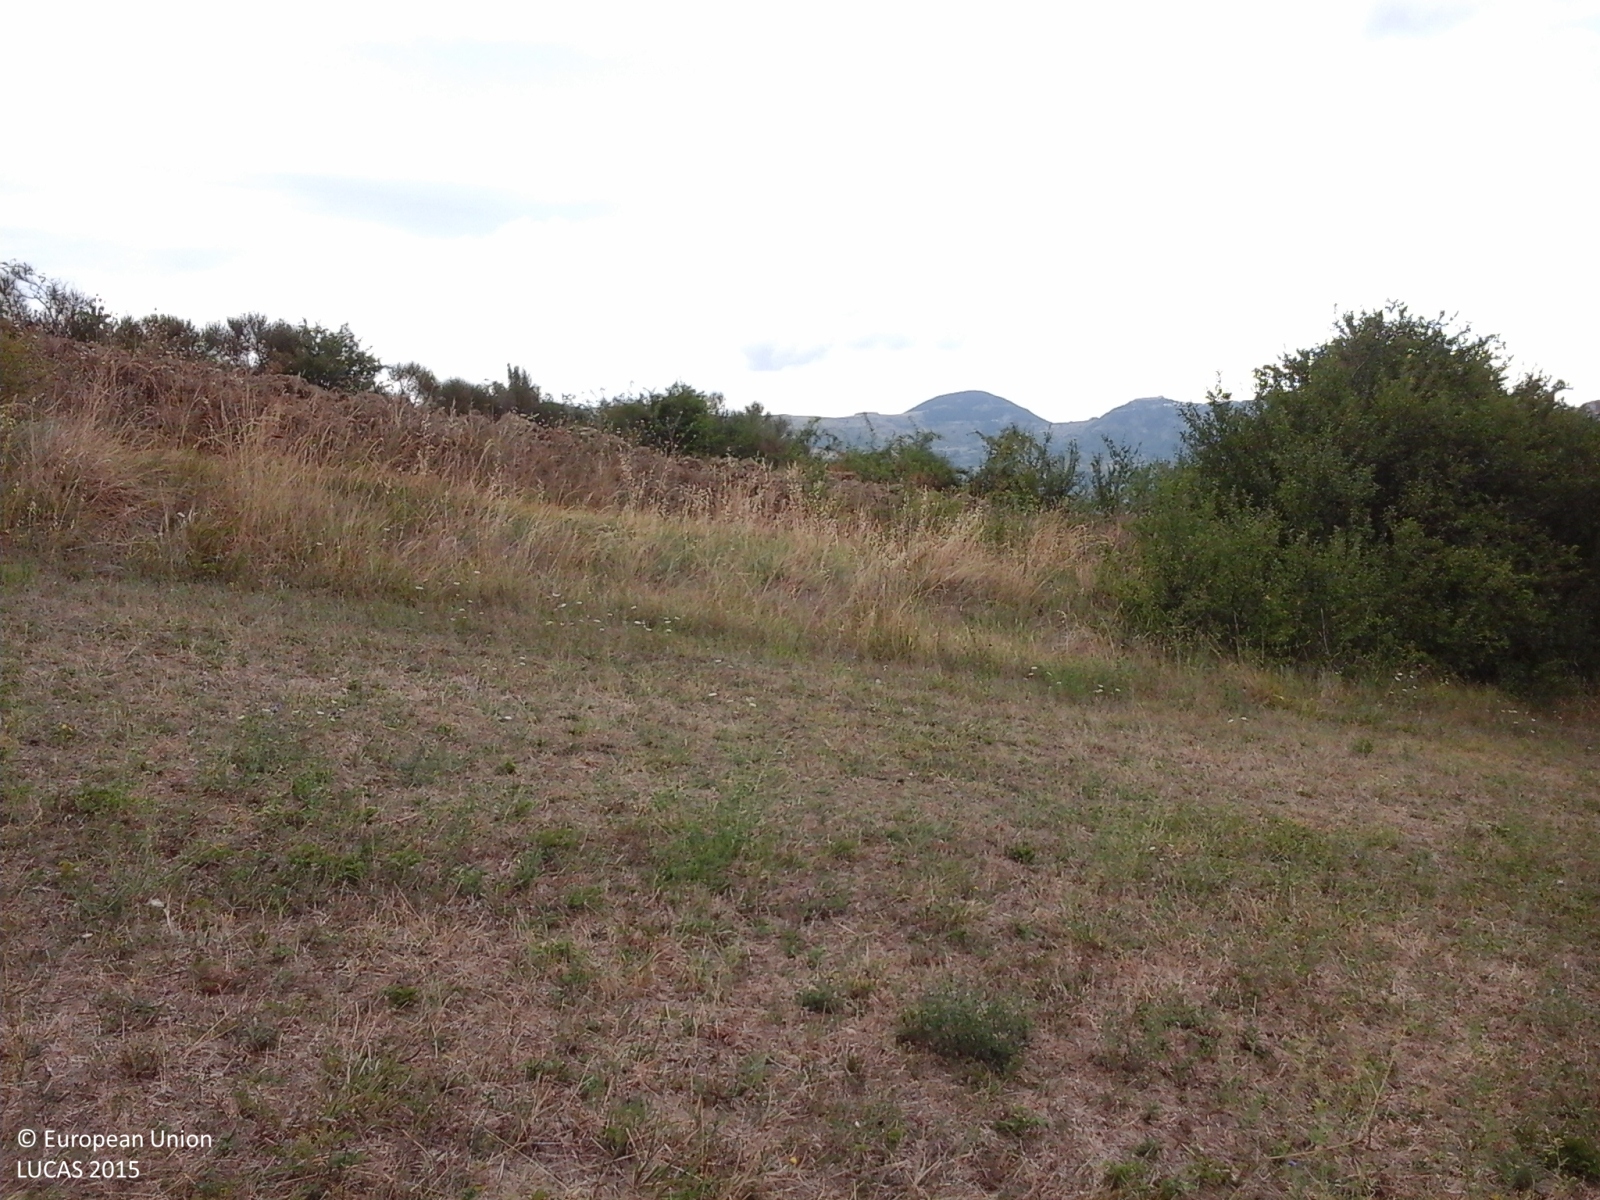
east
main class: Cropland
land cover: Temporary grasslands
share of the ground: > 75 %
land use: Agriculture (excluding fallow land and kitchen gardens)
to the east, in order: Temporary grasslands; Tracks; Temporary grasslands; Shrubland with sparse tree cover; Grassland without tree/shrub cover; Broadleaved woodland; Grassland without tree/shrub cover; Broadleaved woodland; Grassland without tree/shrub cover; Broadleaved woodland
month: August
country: IT
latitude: 41.8346
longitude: 14.4045
